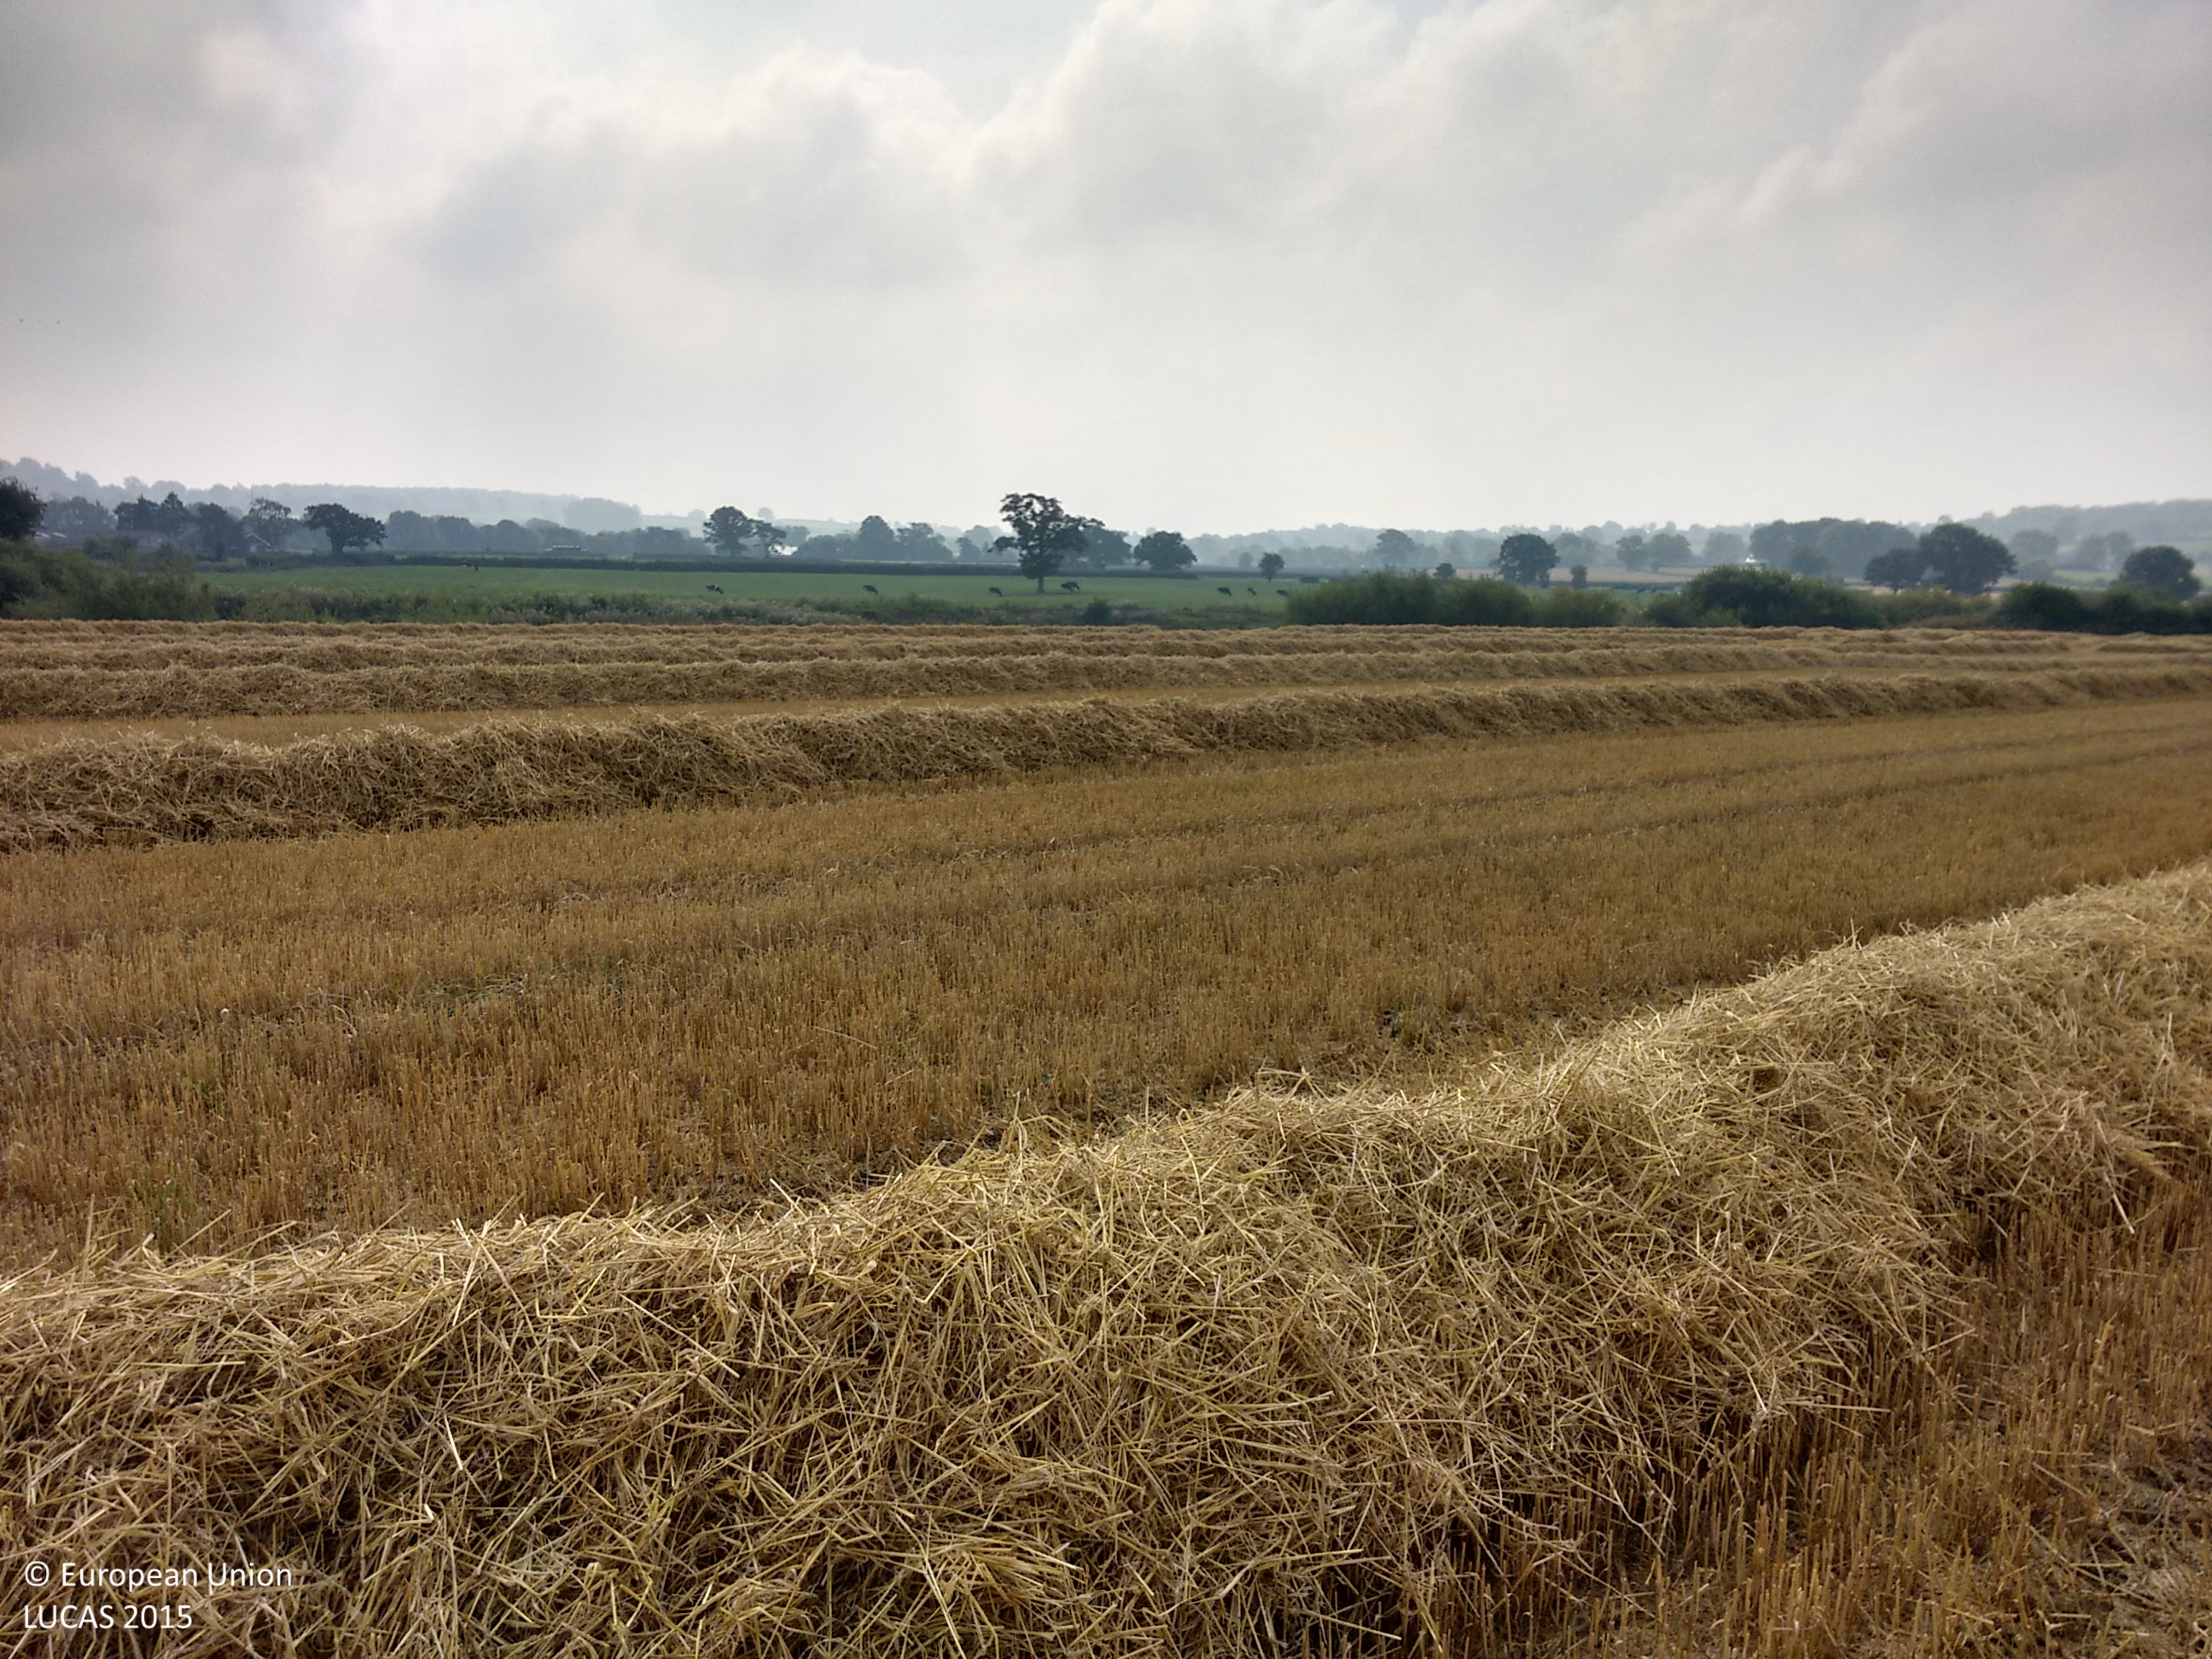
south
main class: Cropland
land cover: Barley
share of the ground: < 10 %
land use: Agriculture (excluding fallow land and kitchen gardens)
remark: Harvested field
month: September
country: GB
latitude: 52.7365
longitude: -2.9743
